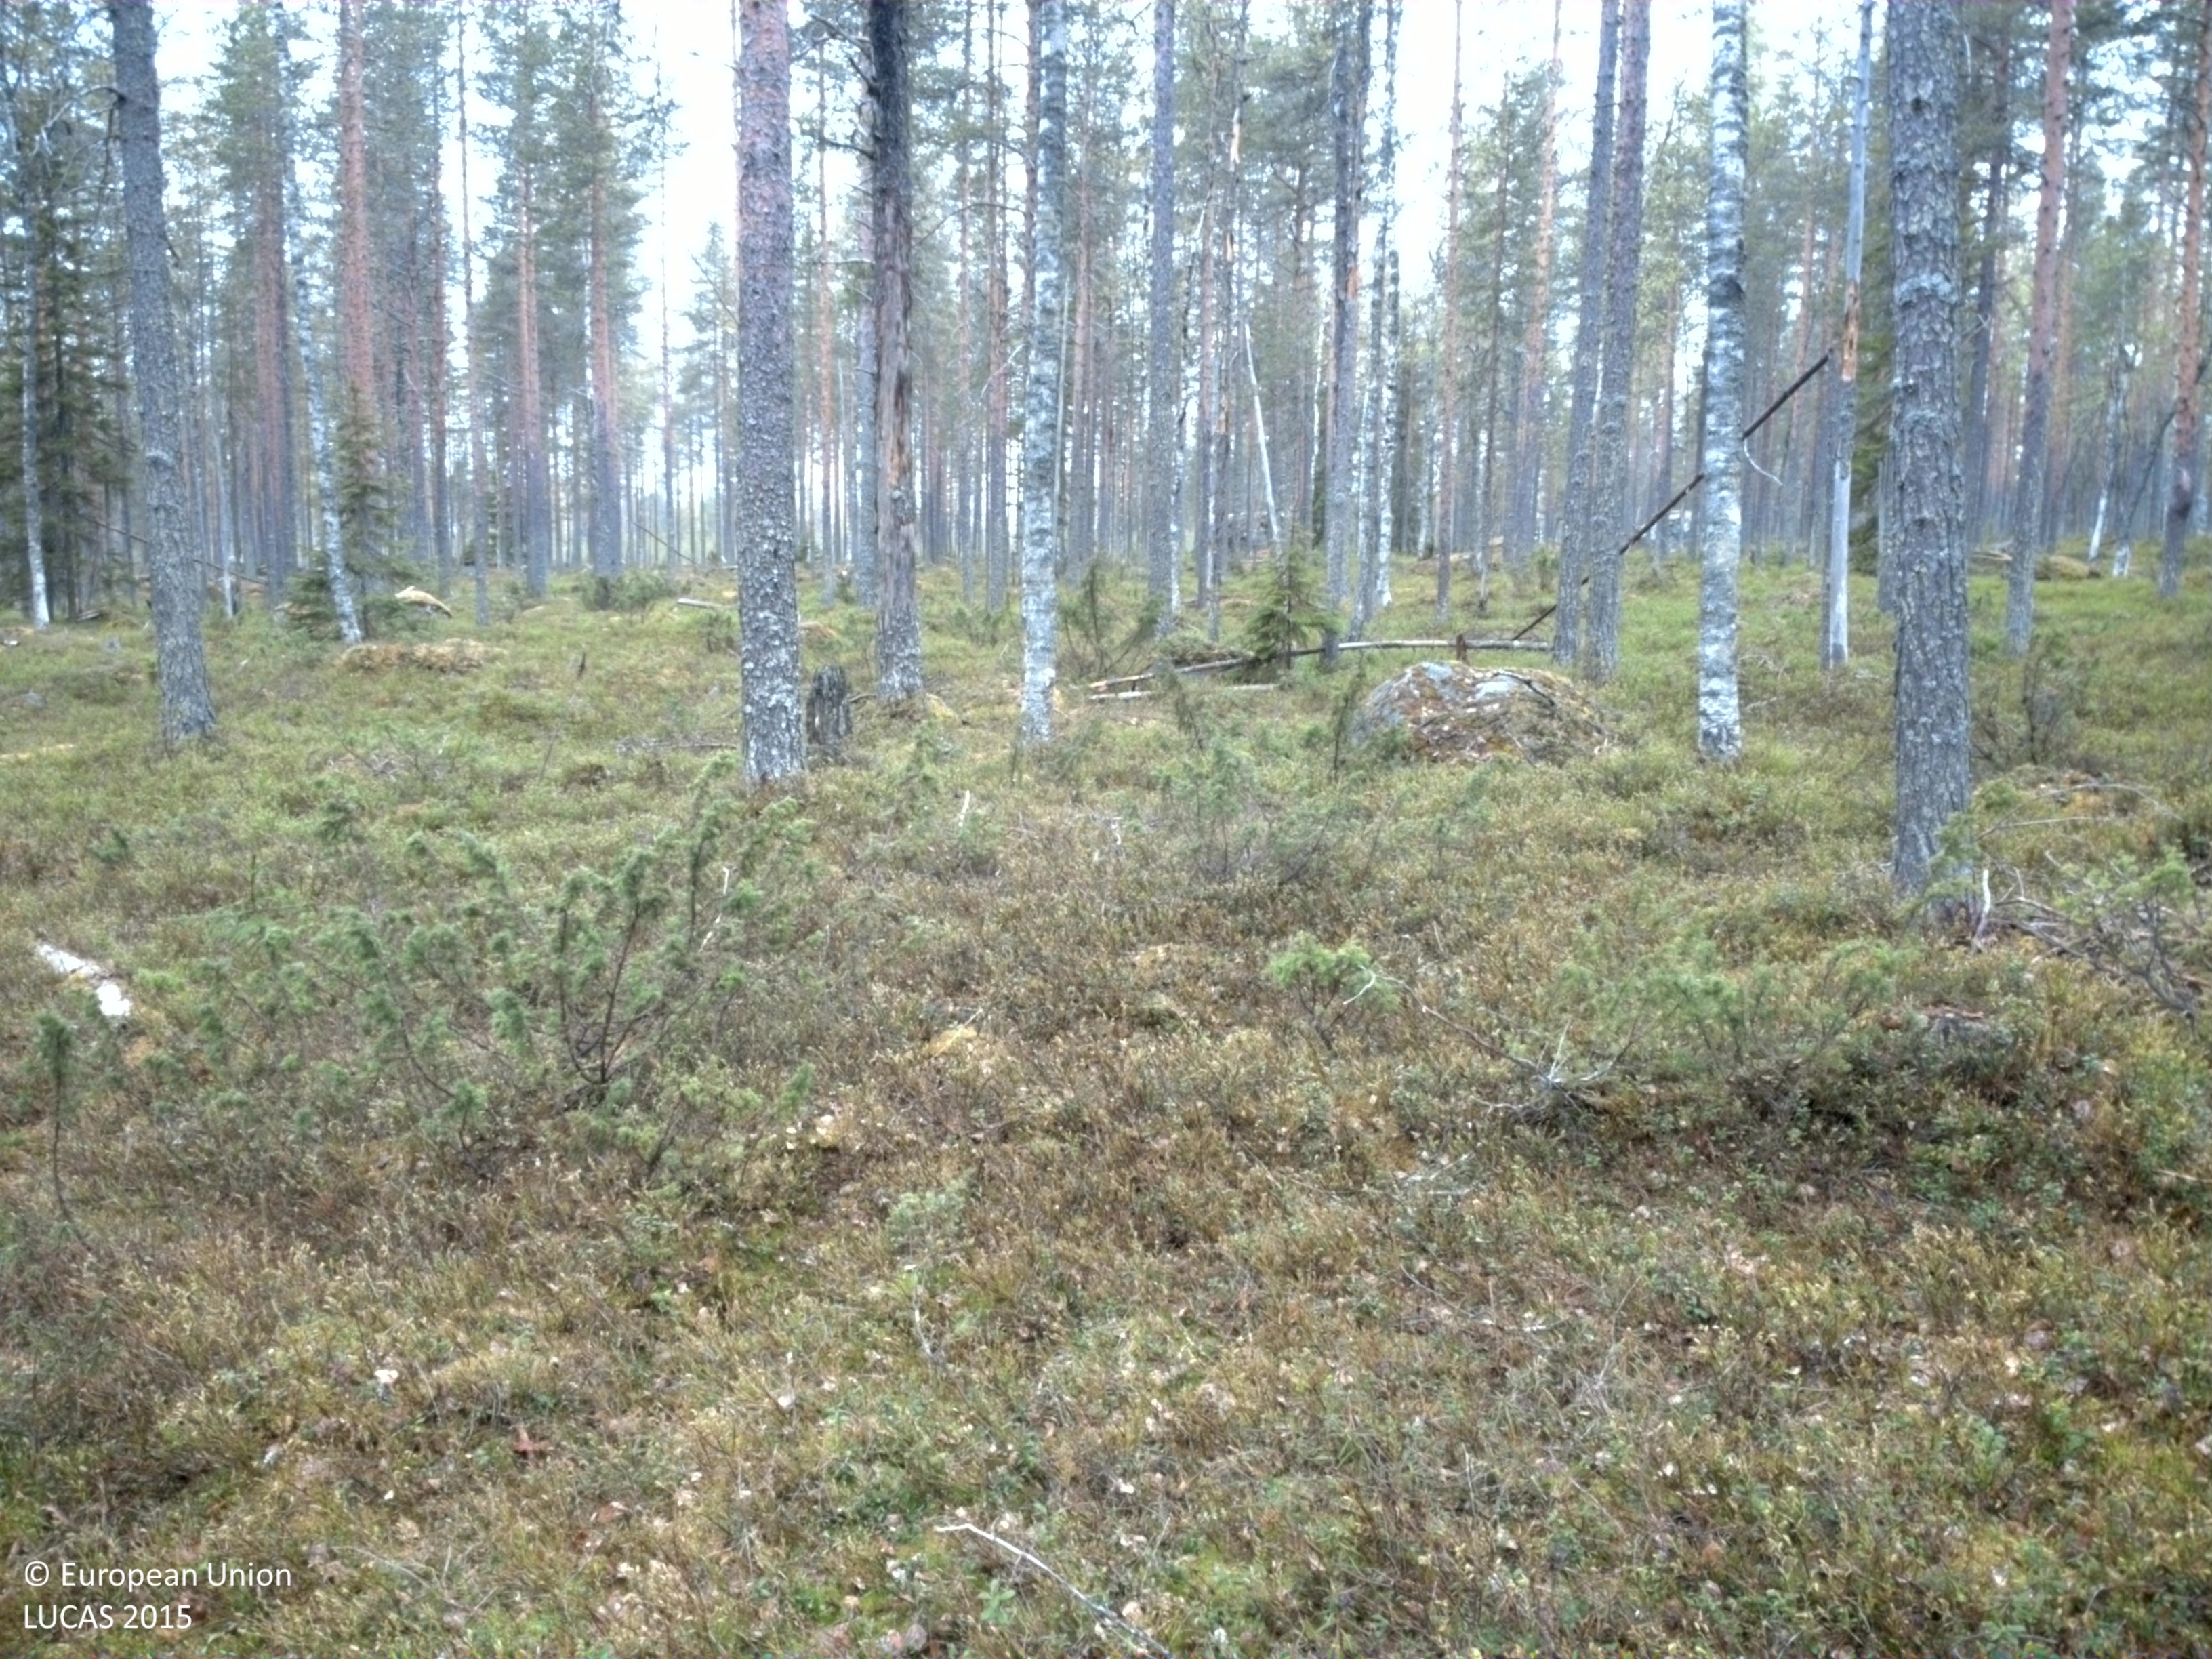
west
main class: Woodland
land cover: Pine dominated coniferous woodland
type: boreal forest
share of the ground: 50 - 75 %
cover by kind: coniferous forest trees 65 %, shrubs 30 %, broadleaved forest trees 5 %
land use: Forestry
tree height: > 5 m
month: May
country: SE
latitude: 66.0388
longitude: 23.3386
